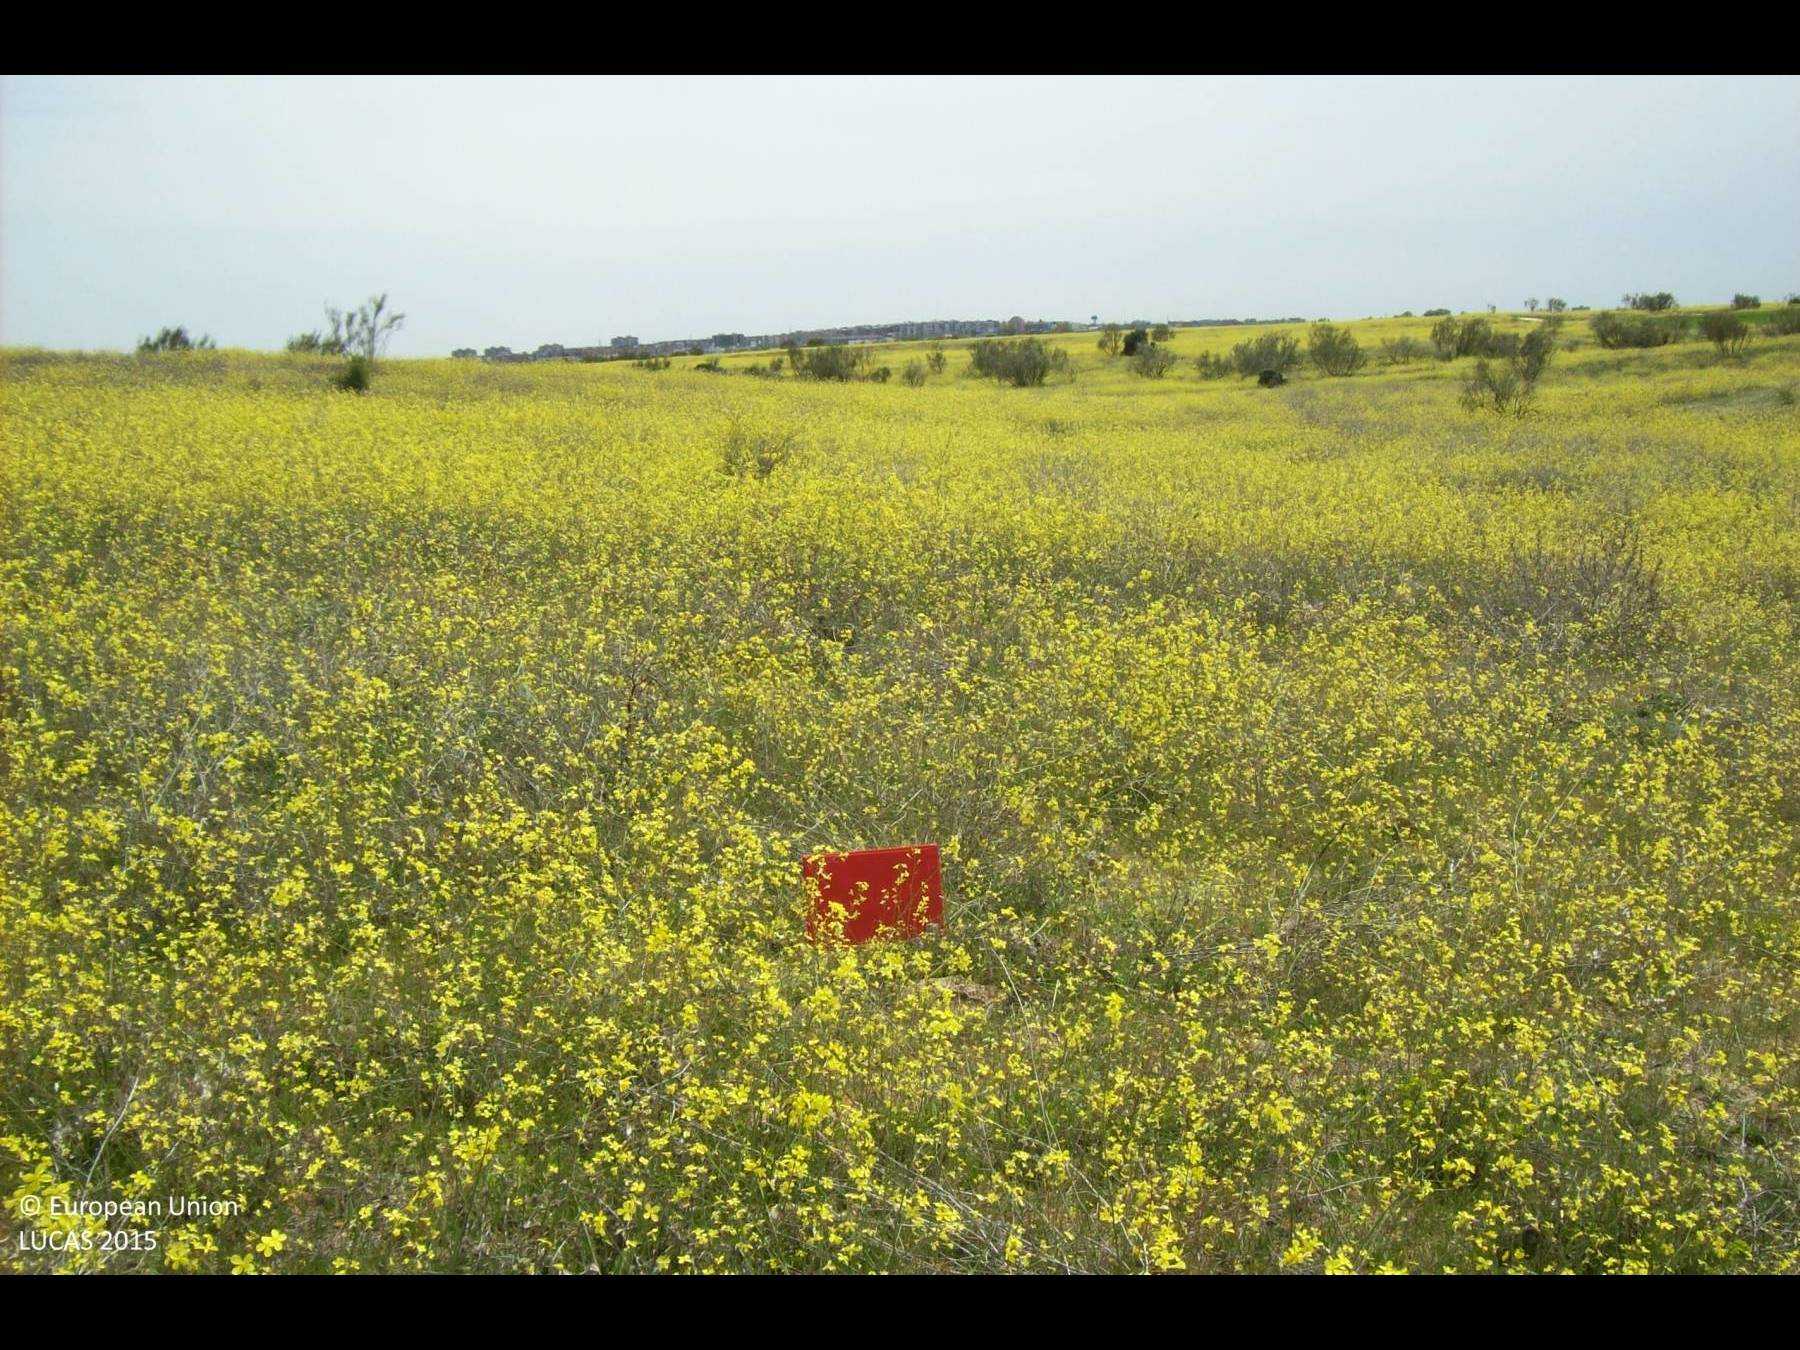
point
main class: Grassland
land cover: Spontaneously vegetated surfaces
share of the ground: > 75 %
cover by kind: herbaceous plants 95 %, shrubs 5 %
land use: Semi-natural and natural areas not in use
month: April
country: ES
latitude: 40.3817
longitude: -3.8322
